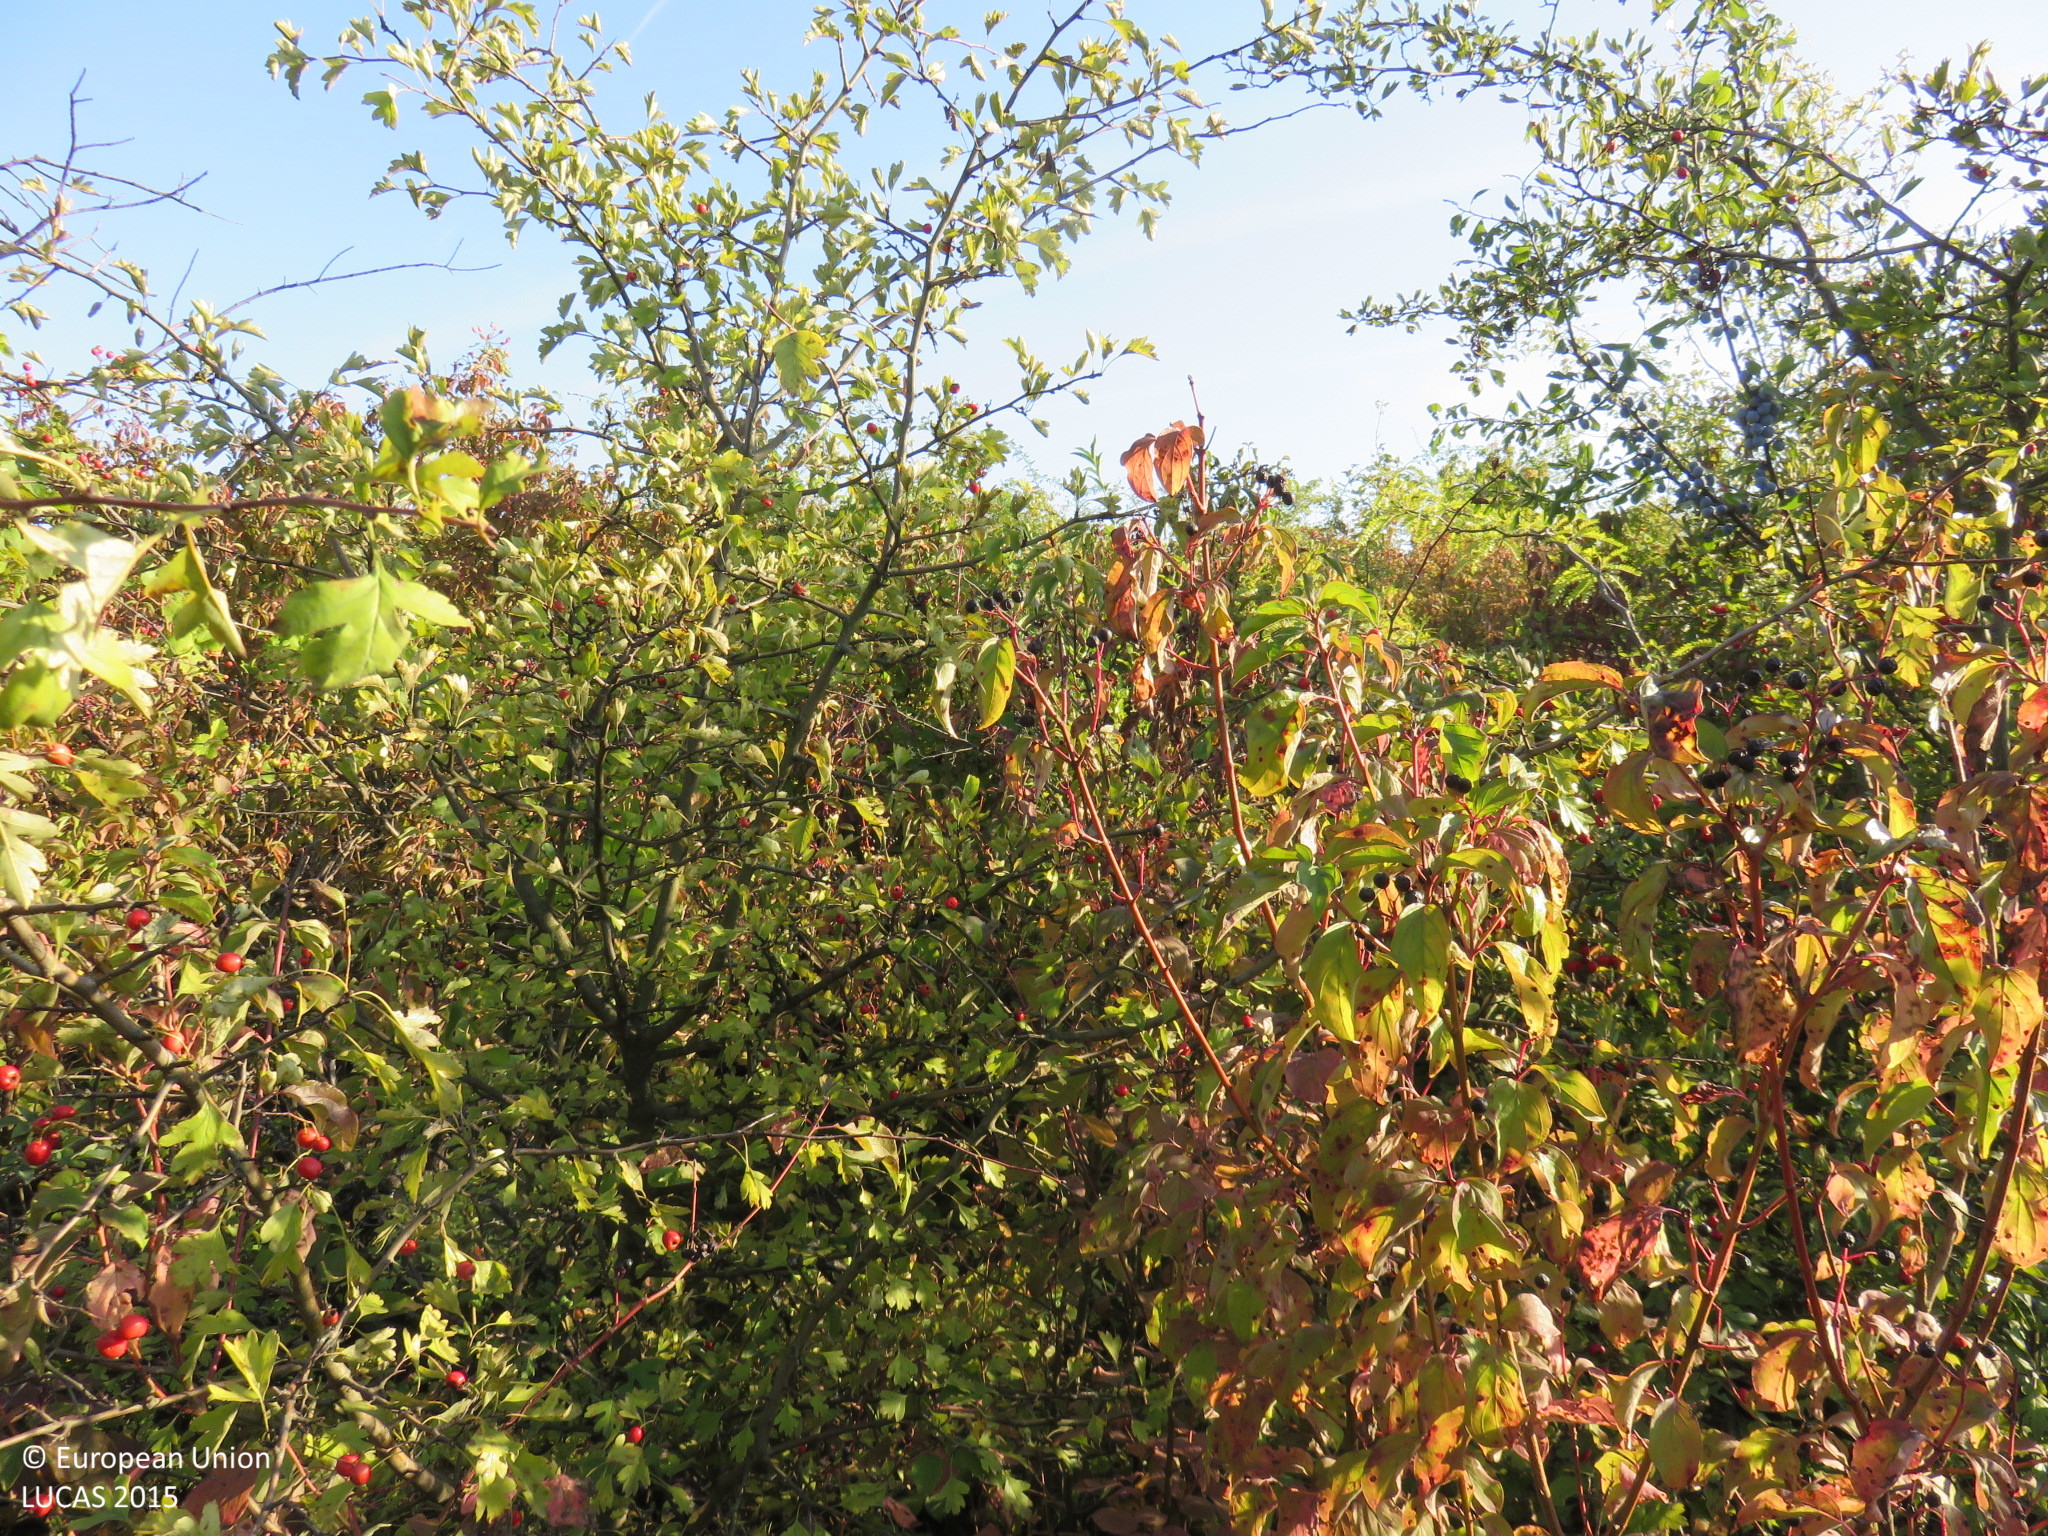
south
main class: Shrubland
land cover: Shrubland with sparse tree cover
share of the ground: > 75 %
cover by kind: shrubs 90 %, broadleaved forest trees 5 %
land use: Abandoned areas
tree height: < 5 m
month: September
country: BG
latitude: 43.6540
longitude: 24.5082
